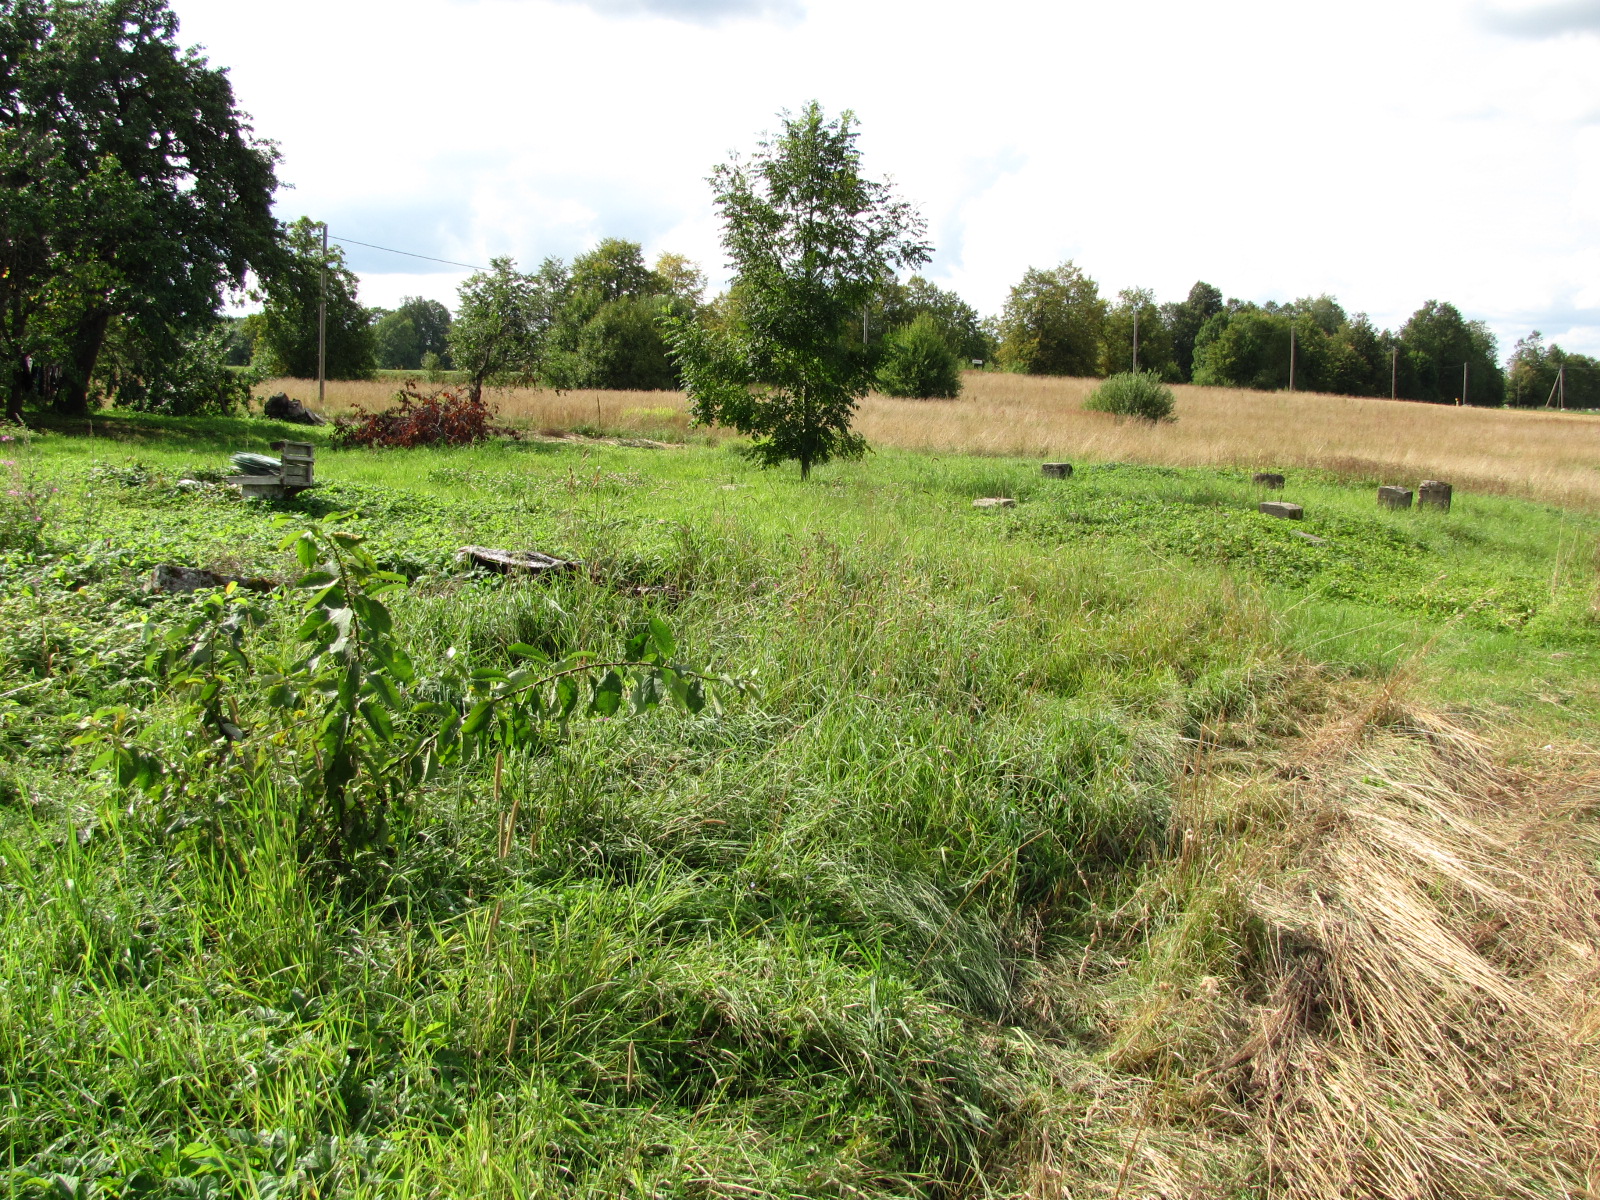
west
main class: Grassland
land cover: Grassland without tree/shrub cover
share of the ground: > 75 %
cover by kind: herbaceous plants 100 %
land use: Agriculture (excluding fallow land and kitchen gardens)
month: August
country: LV
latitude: 56.8891
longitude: 25.1949
